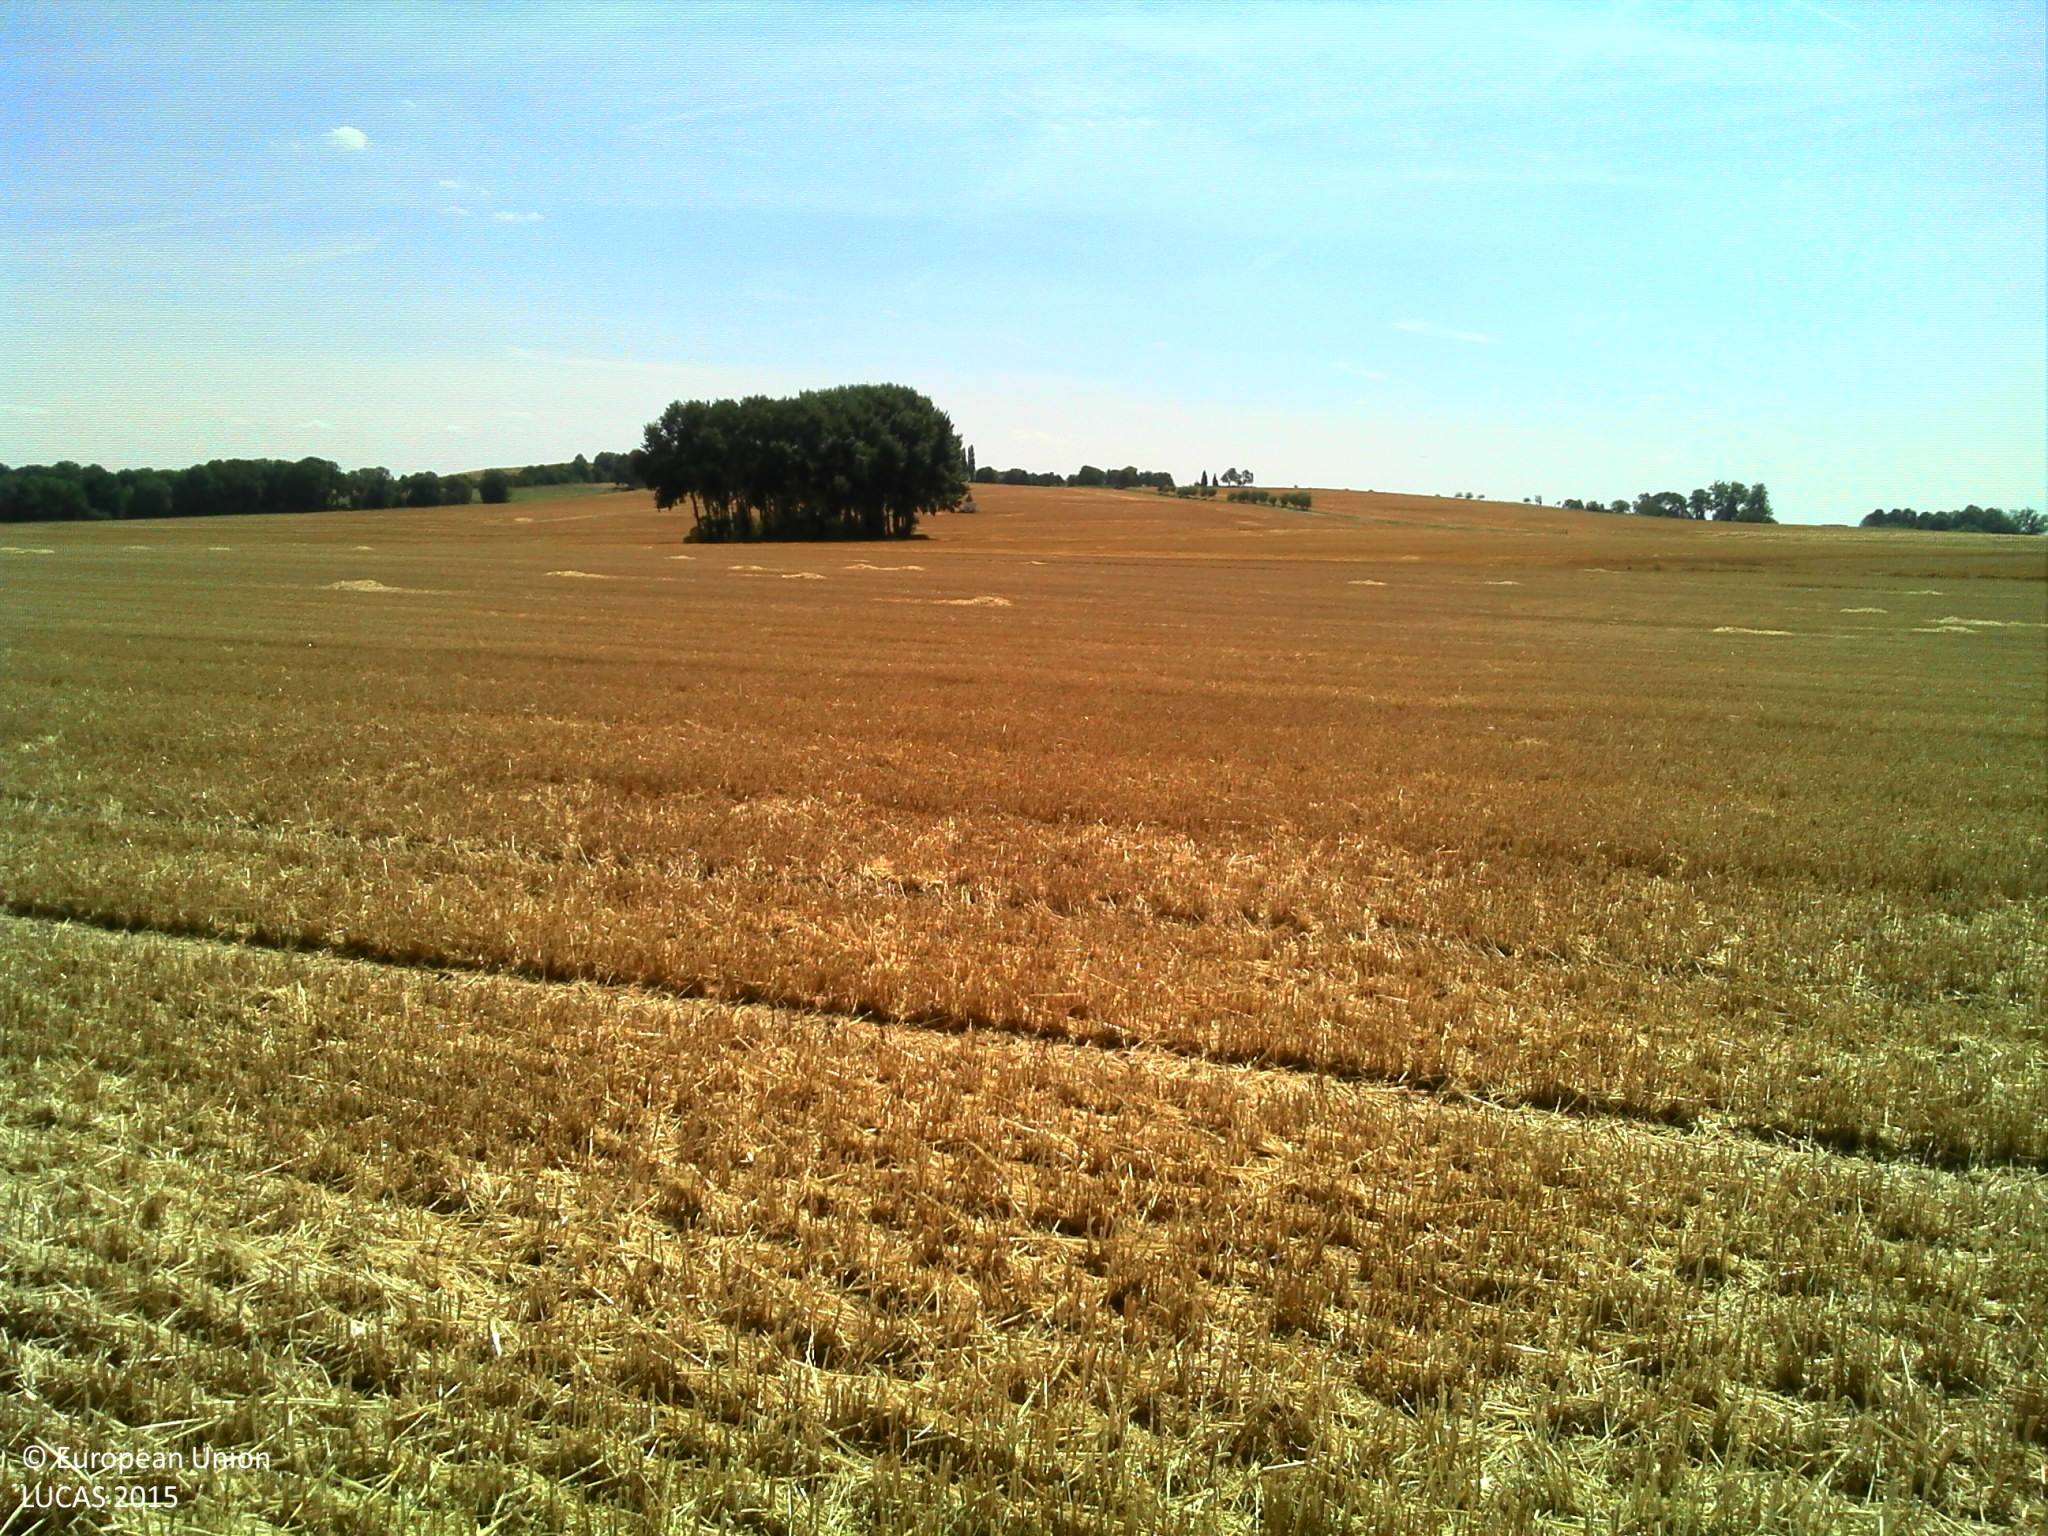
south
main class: Cropland
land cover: Common wheat
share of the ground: > 75 %
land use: Agriculture (excluding fallow land and kitchen gardens)
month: July
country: FR
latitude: 49.0825
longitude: 2.4166
